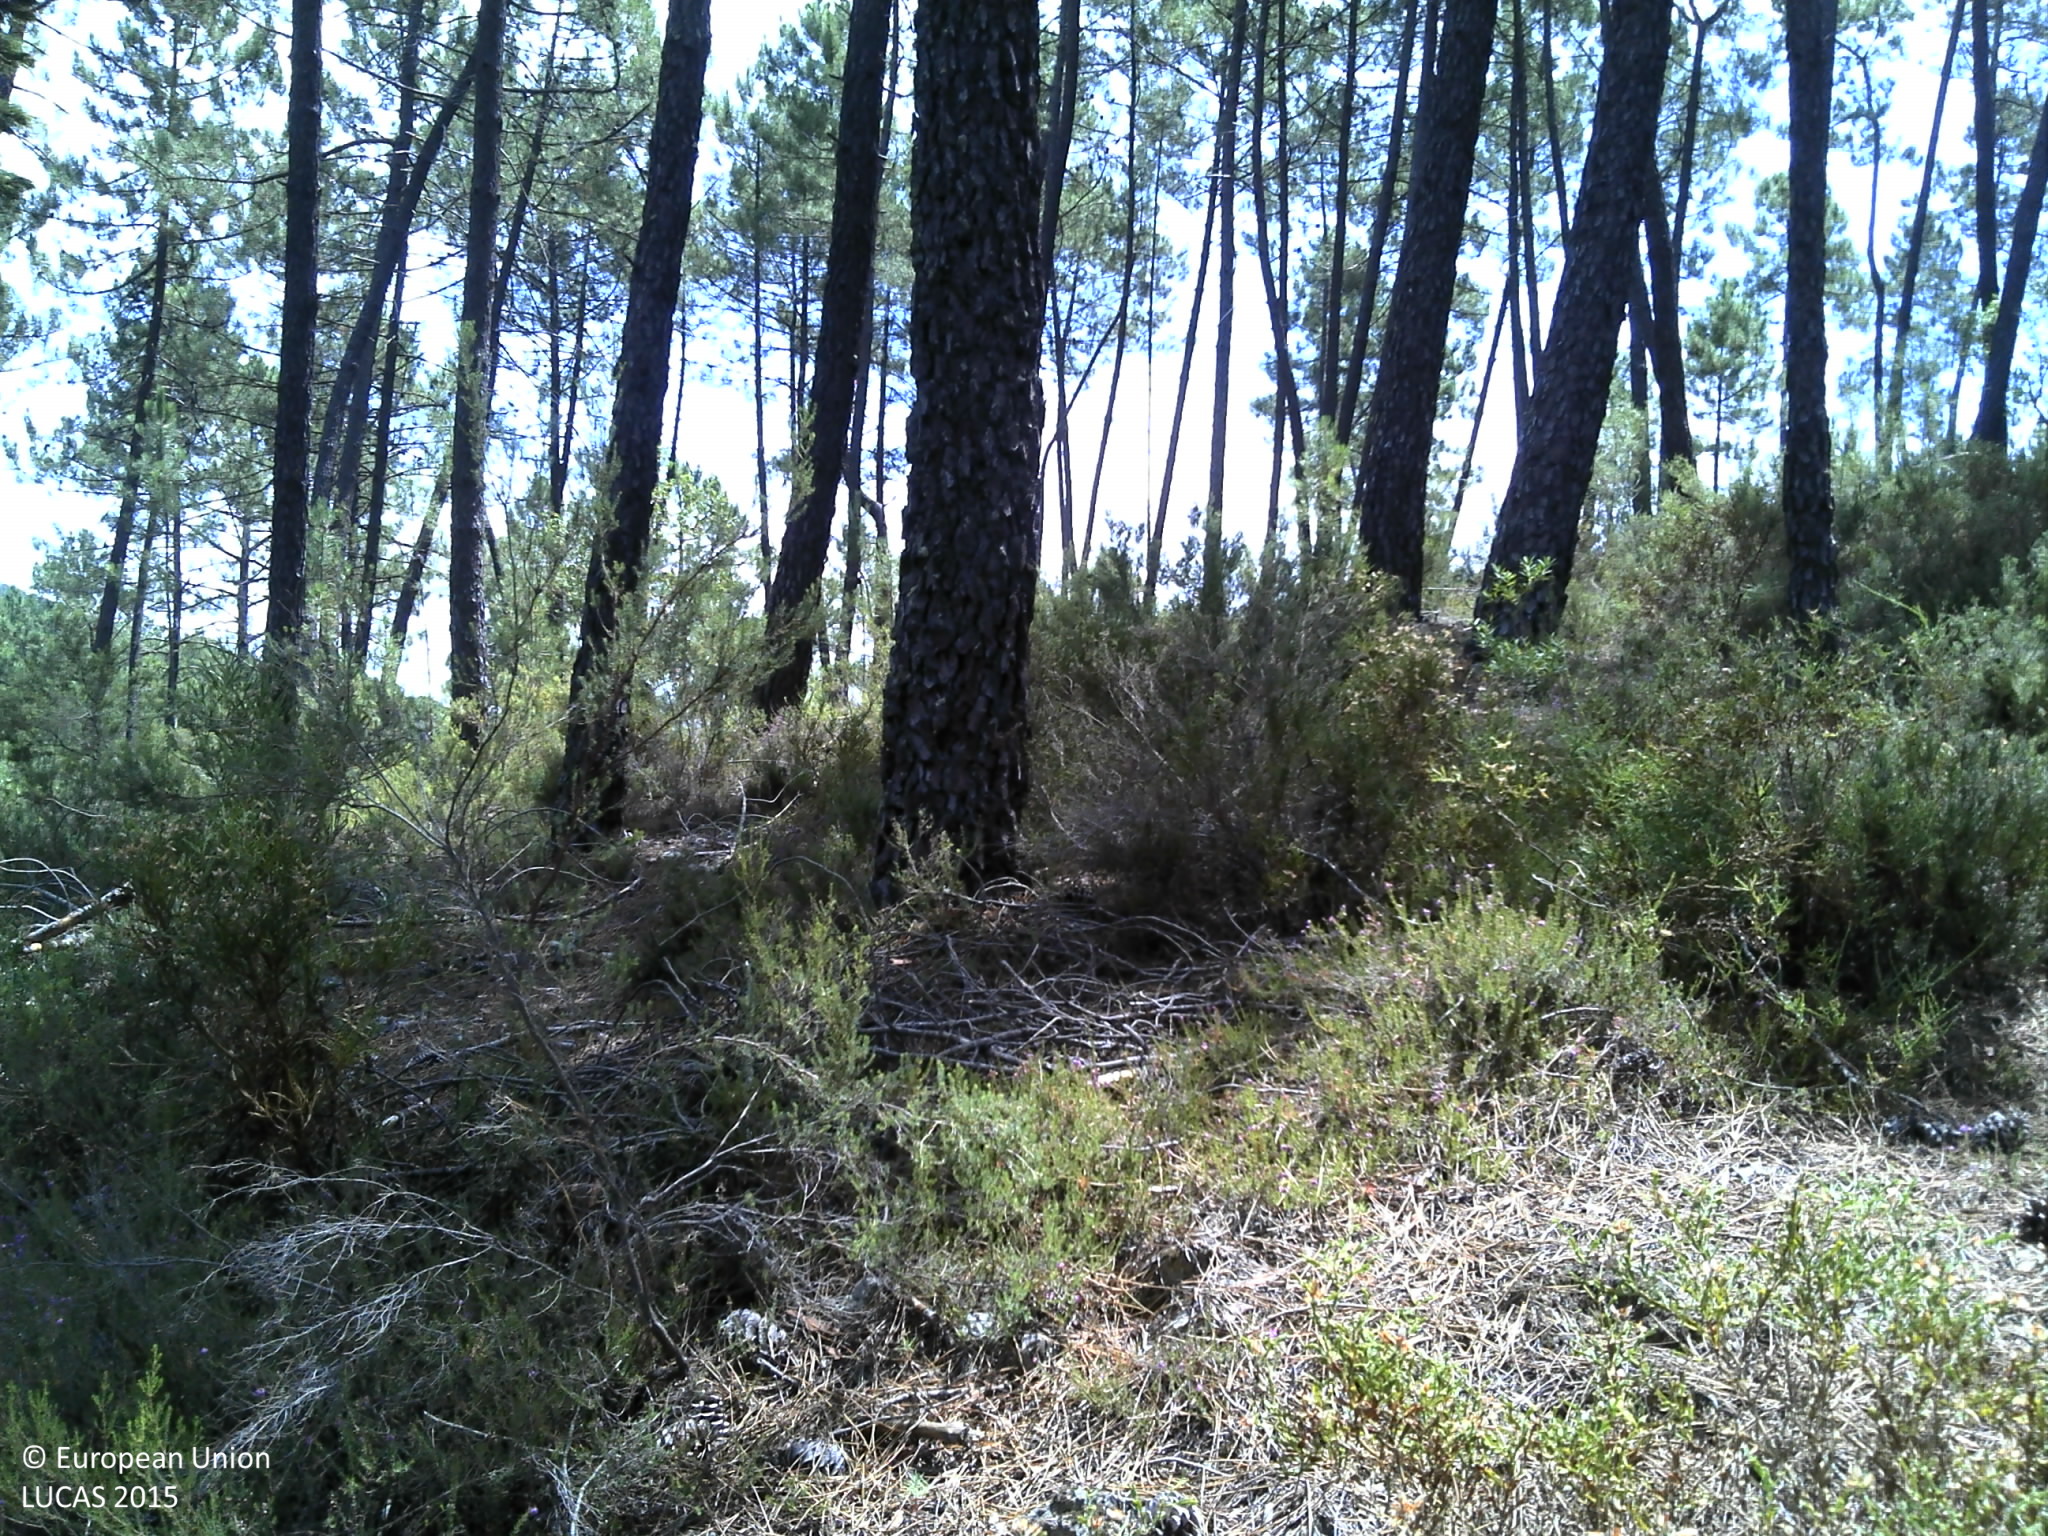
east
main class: Woodland
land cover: Pine dominated coniferous woodland
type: coniferous forest of the mediterranean region
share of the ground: 10 - 25 %
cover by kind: shrubs 50 %, unconsolidated bare surface 35 %, coniferous forest trees 15 %
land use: Forestry
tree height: > 5 m
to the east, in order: Pine dominated coniferous woodland; Tracks; Pine dominated coniferous woodland; Paved roads, cycling and walking lanes; Shrubland with sparse tree cover; Tracks; Shrubland with sparse tree cover; Nuts trees; Dry stone walls; Rivers and streams; Dry stone walls; Vineyards; Other fresh vegetables; Pine dominated coniferous woodland
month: July
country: PT
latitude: 39.8768
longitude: -7.8220
